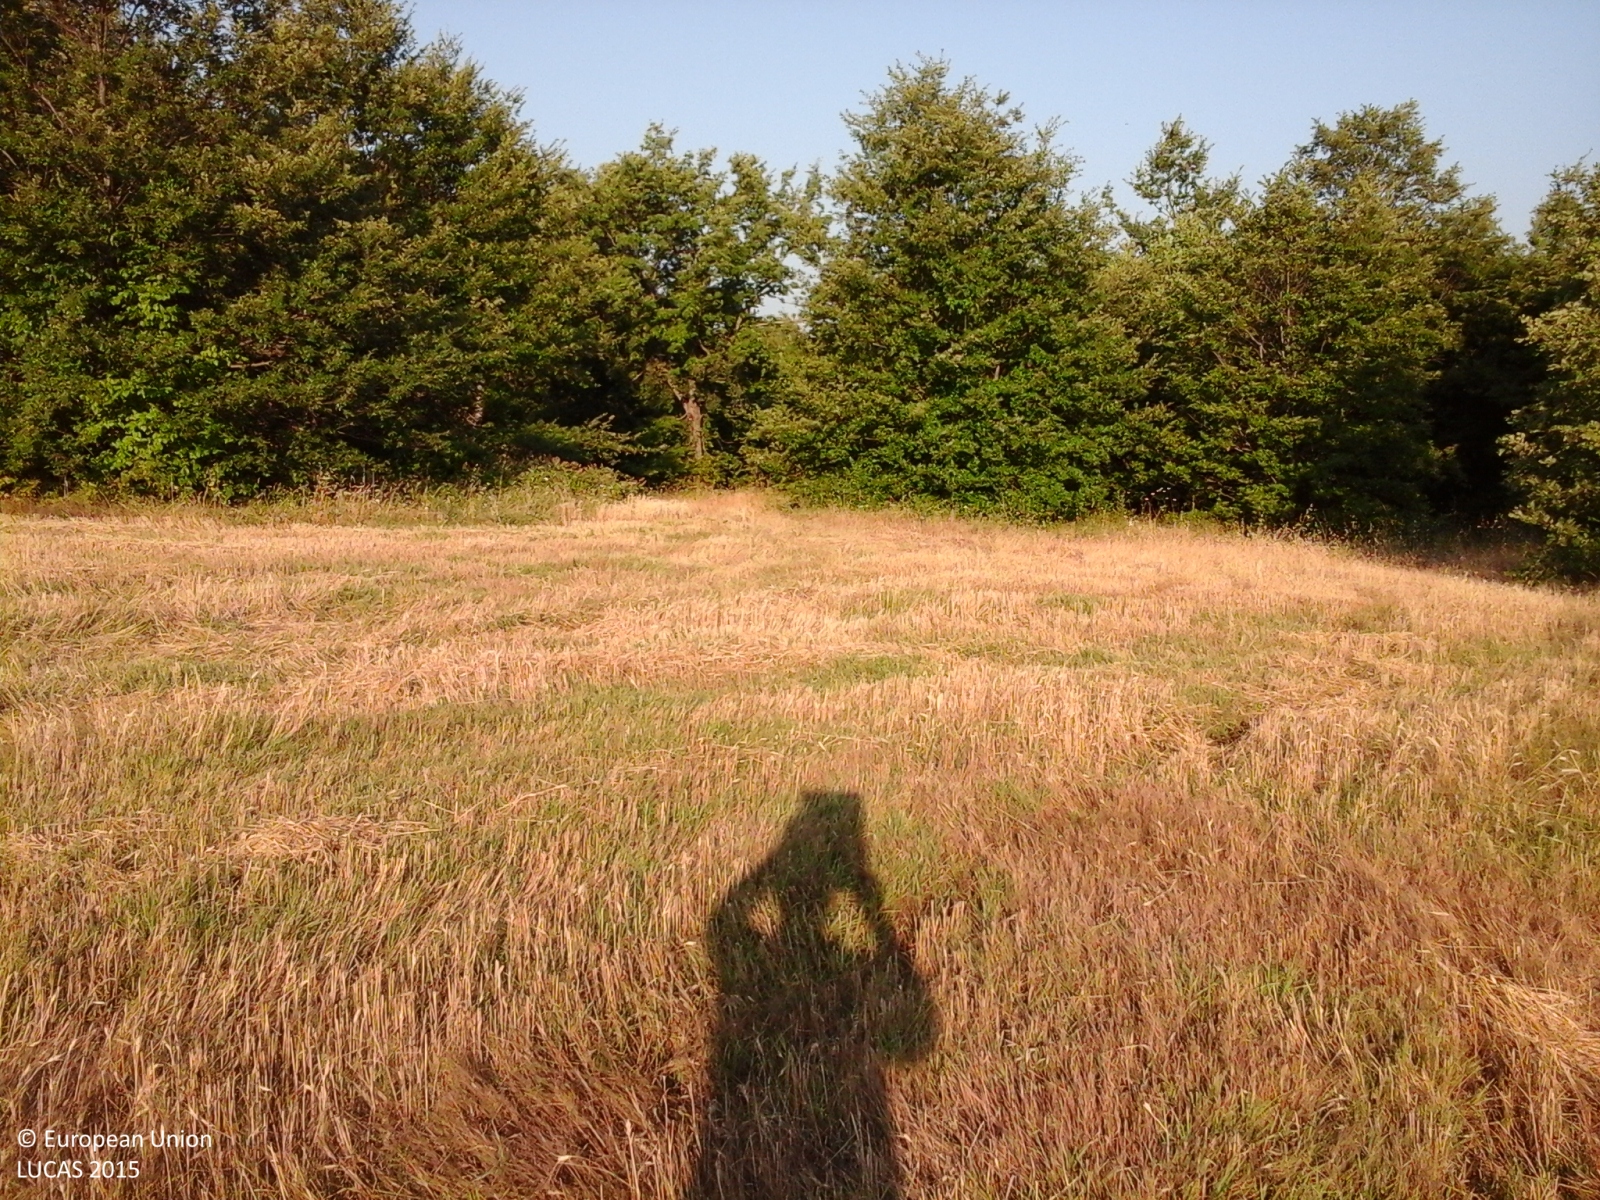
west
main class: Cropland
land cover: Durum wheat
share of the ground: > 75 %
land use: Agriculture (excluding fallow land and kitchen gardens)
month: July
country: IT
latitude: 41.5487
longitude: 14.7190
